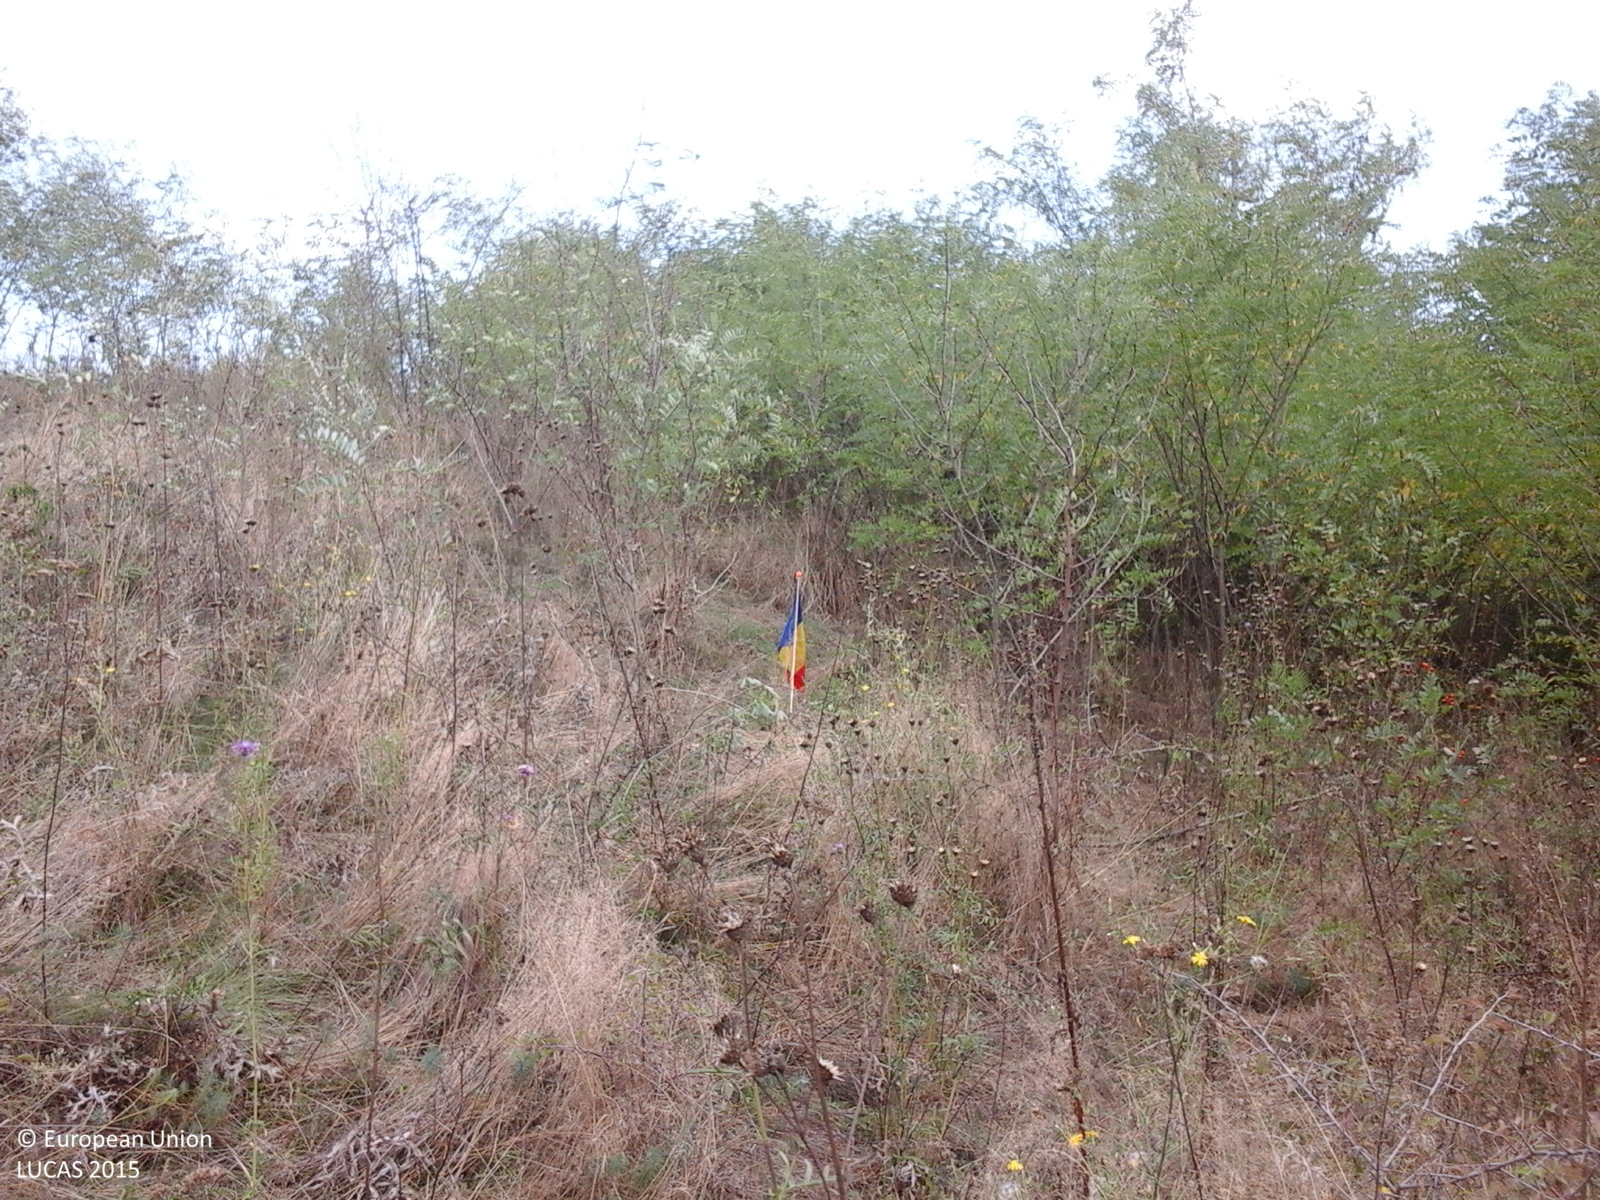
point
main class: Woodland
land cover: Broadleaved woodland
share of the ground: > 75 %
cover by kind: broadleaved forest trees 100 %
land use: Forestry
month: September
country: RO
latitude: 45.4081
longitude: 22.2431
